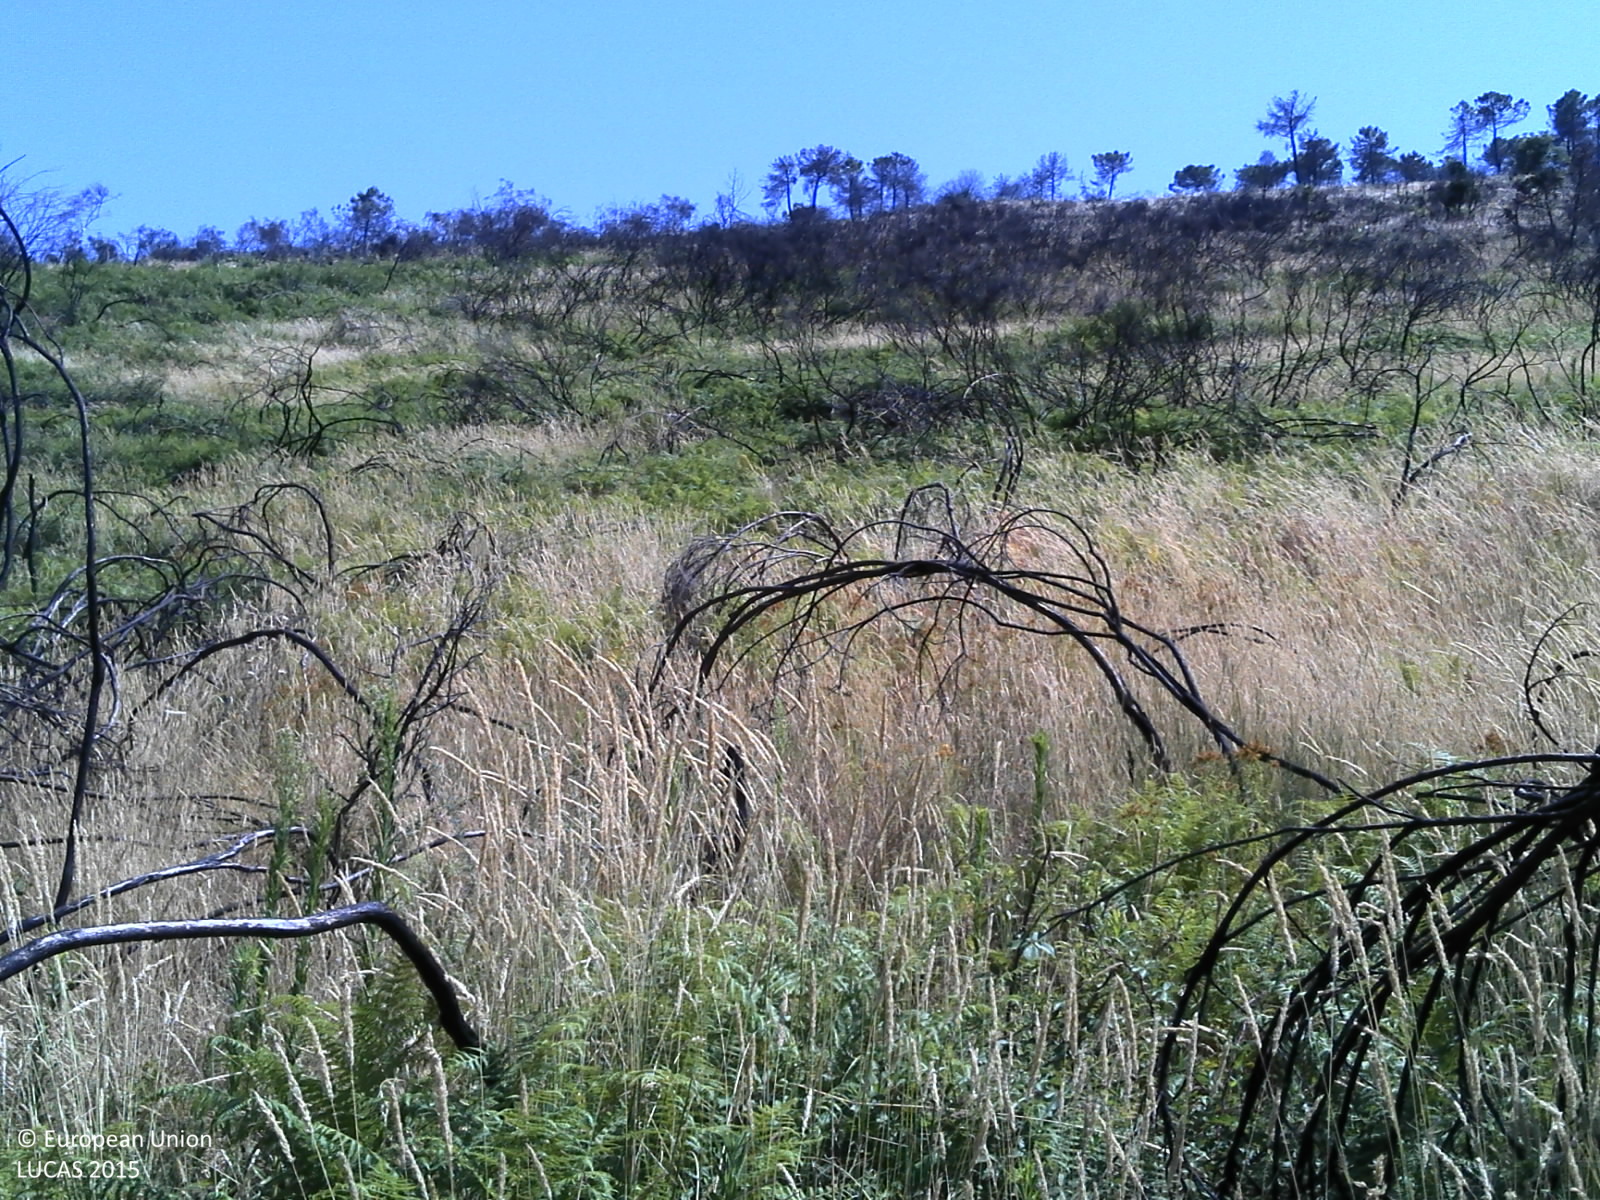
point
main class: Shrubland
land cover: Shrubland without tree cover
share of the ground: > 75 %
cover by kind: shrubs 100 %
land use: Semi-natural and natural areas not in use
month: July
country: PT
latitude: 41.0458
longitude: -7.3791
